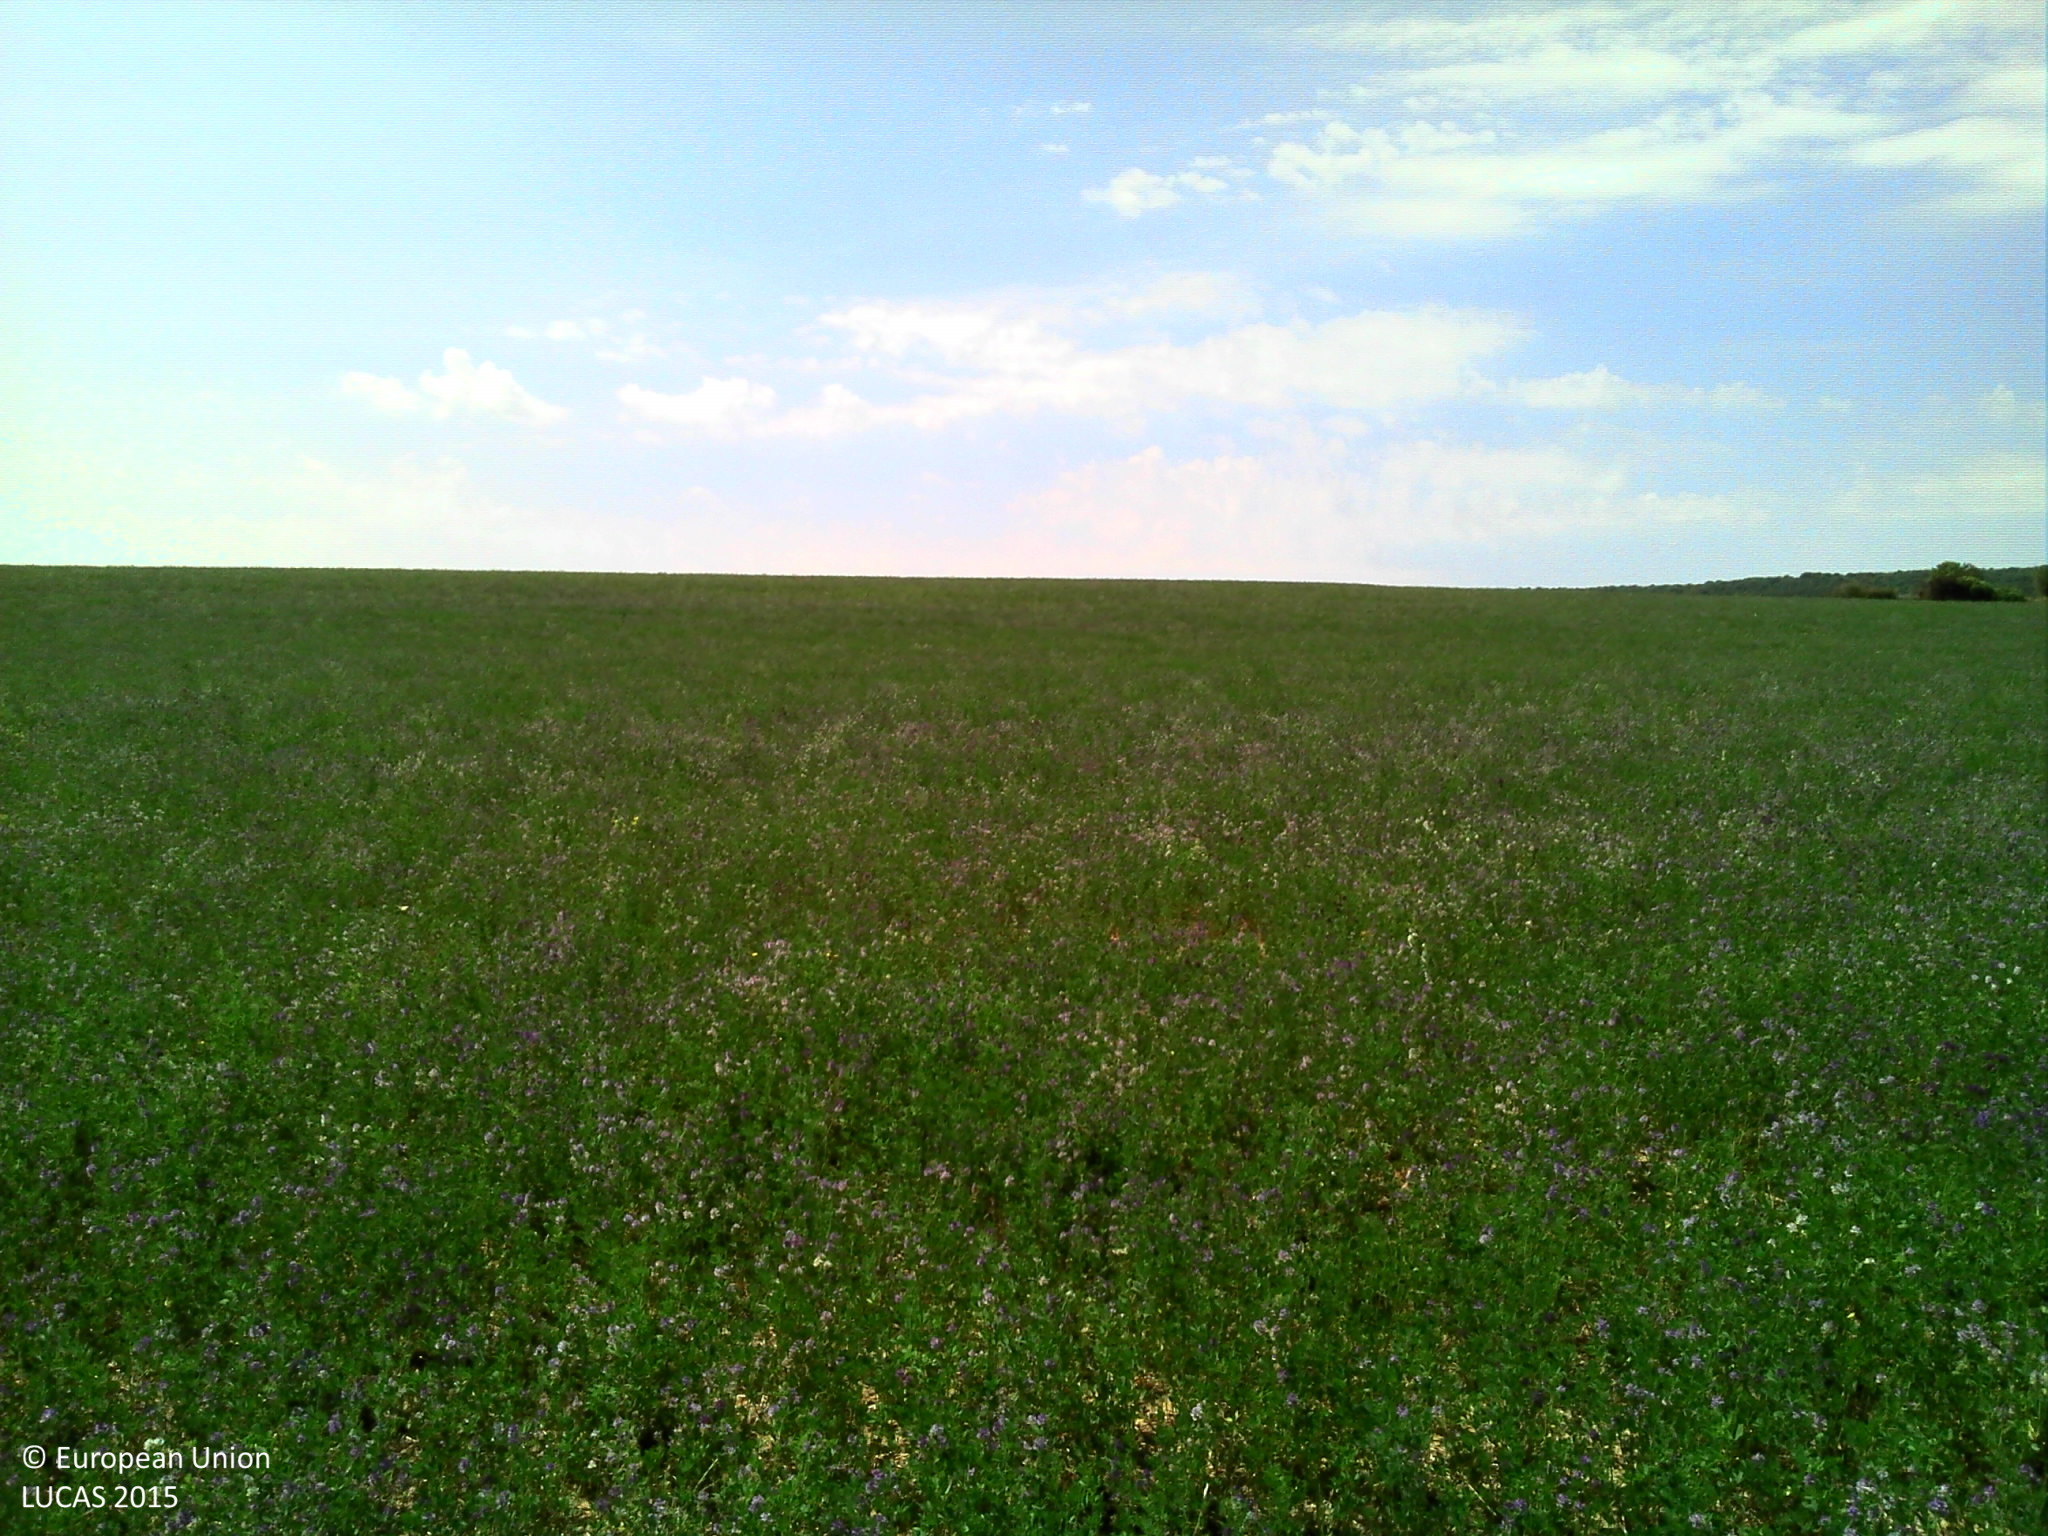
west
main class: Cropland
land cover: Lucerne
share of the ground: > 75 %
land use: Agriculture (excluding fallow land and kitchen gardens)
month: August
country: FR
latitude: 49.0991
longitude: 4.2022
